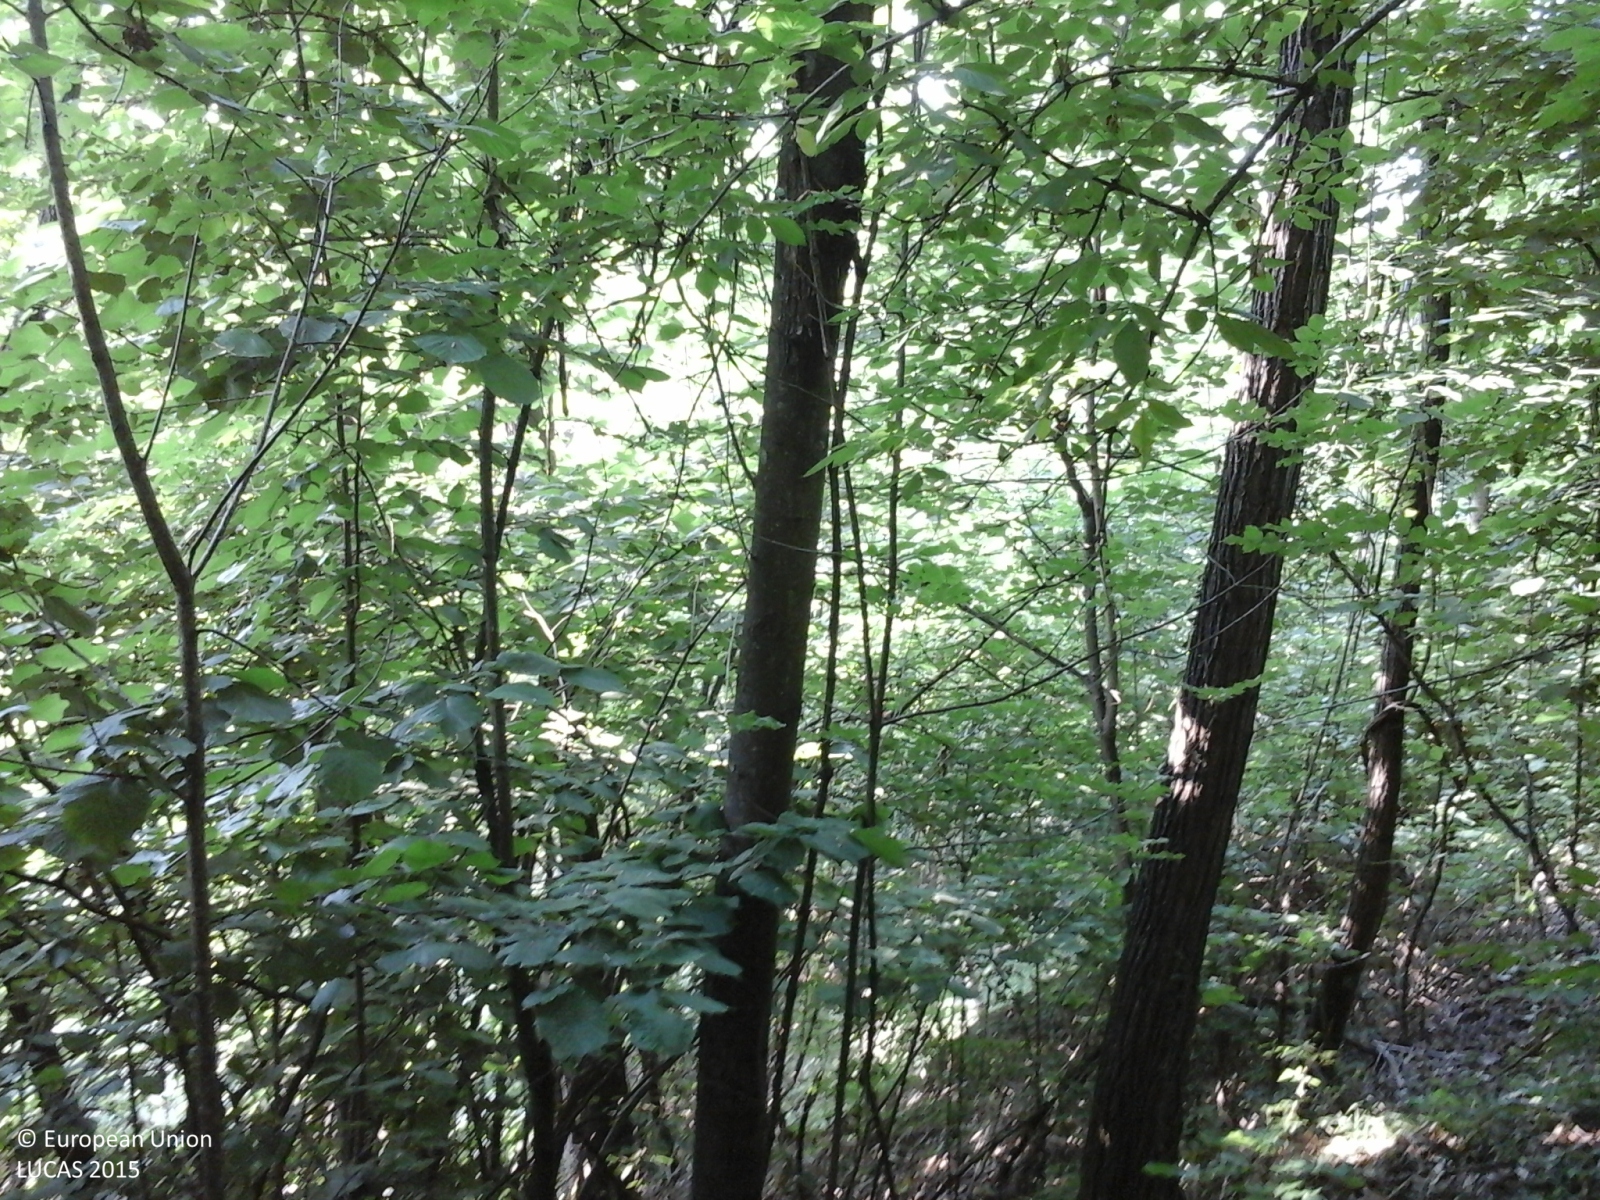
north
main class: Woodland
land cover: Broadleaved woodland
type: thermophilous deciduous forest
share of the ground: > 75 %
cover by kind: broadleaved forest trees 95 %, shrubs 5 %
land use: Forestry
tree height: > 5 m
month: June
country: IT
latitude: 44.5919
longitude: 8.4790
